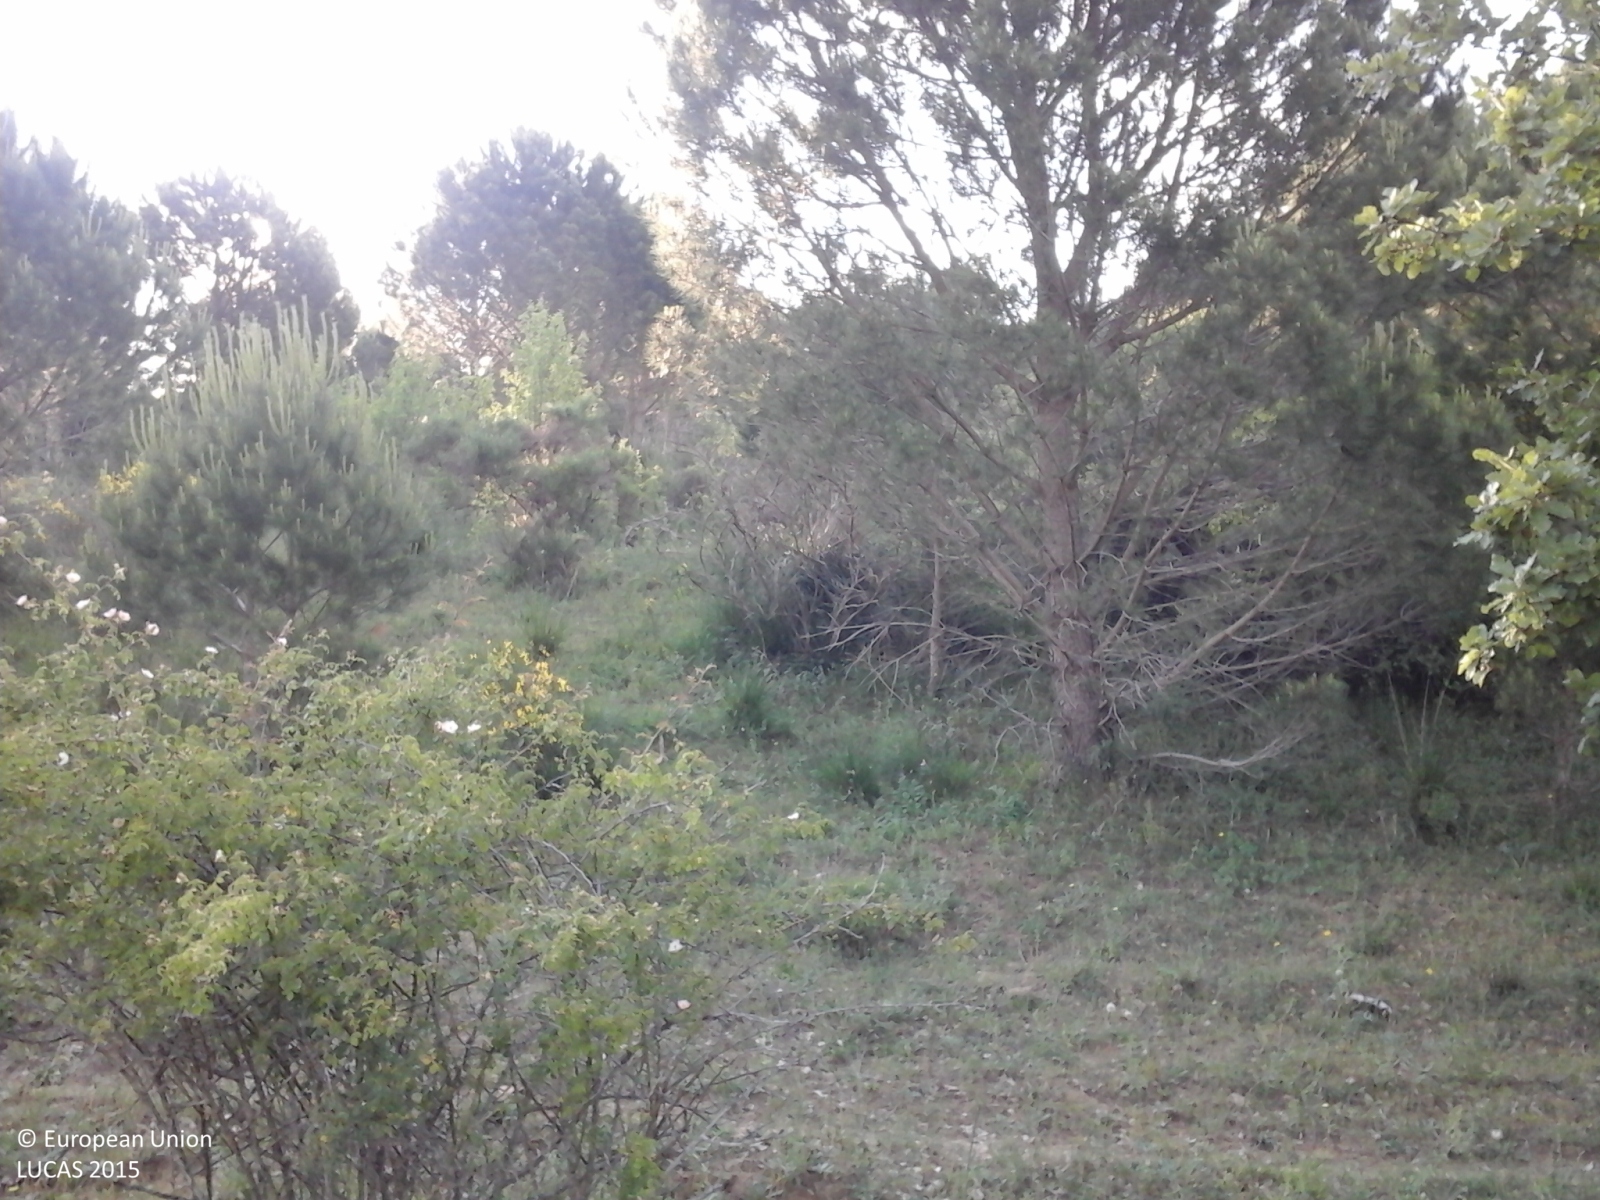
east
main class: Woodland
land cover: Broadleaved woodland
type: broadleaved evergreen forest
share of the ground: > 75 %
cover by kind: broadleaved forest trees 90 %, shrubs 10 %
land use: Forestry
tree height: > 5 m
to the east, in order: Broadleaved woodland; Ditches and canals; Broadleaved woodland; Fences; Other mixed woodland; Tracks; Other mixed woodland
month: June
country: IT
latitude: 37.3909
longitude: 14.4059
